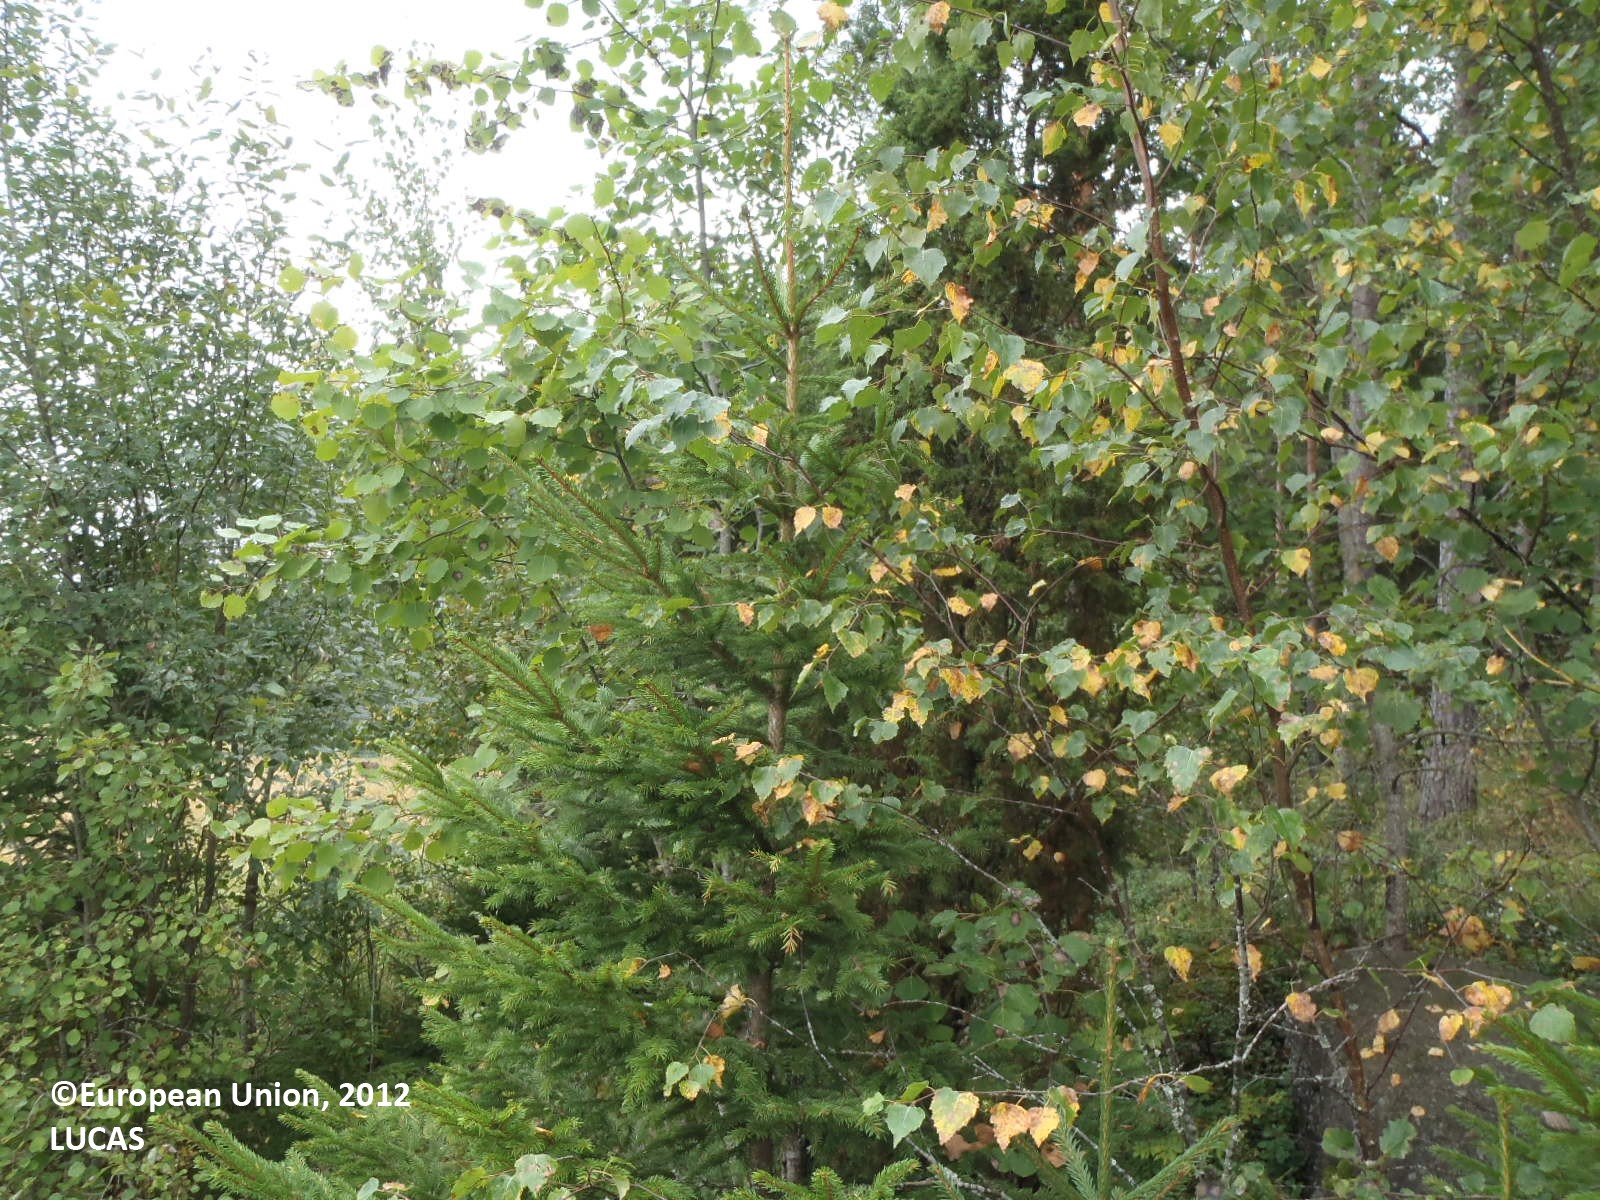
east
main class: Cropland
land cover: Barley
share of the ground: > 75 %
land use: Agriculture (excluding fallow land and kitchen gardens)
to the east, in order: Barley; Grass margins; Ditches and canals; Grassland without tree/shrub cover; Broadleaved woodland; Ditches and canals; Grass margins; Paved roads, cycling and walking lanes; Grass margins; Ditches and canals; Grass margins; Common wheat; Ditches and canals; Grassland without tree/shrub cover; Floriculture and ornamental plants; Grassland without tree/shrub cover; Managed hedges; Grass margins; Paved roads, cycling and walking lanes; Grassland without tree/shrub cover
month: August
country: FI
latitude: 60.5555
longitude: 22.2668
